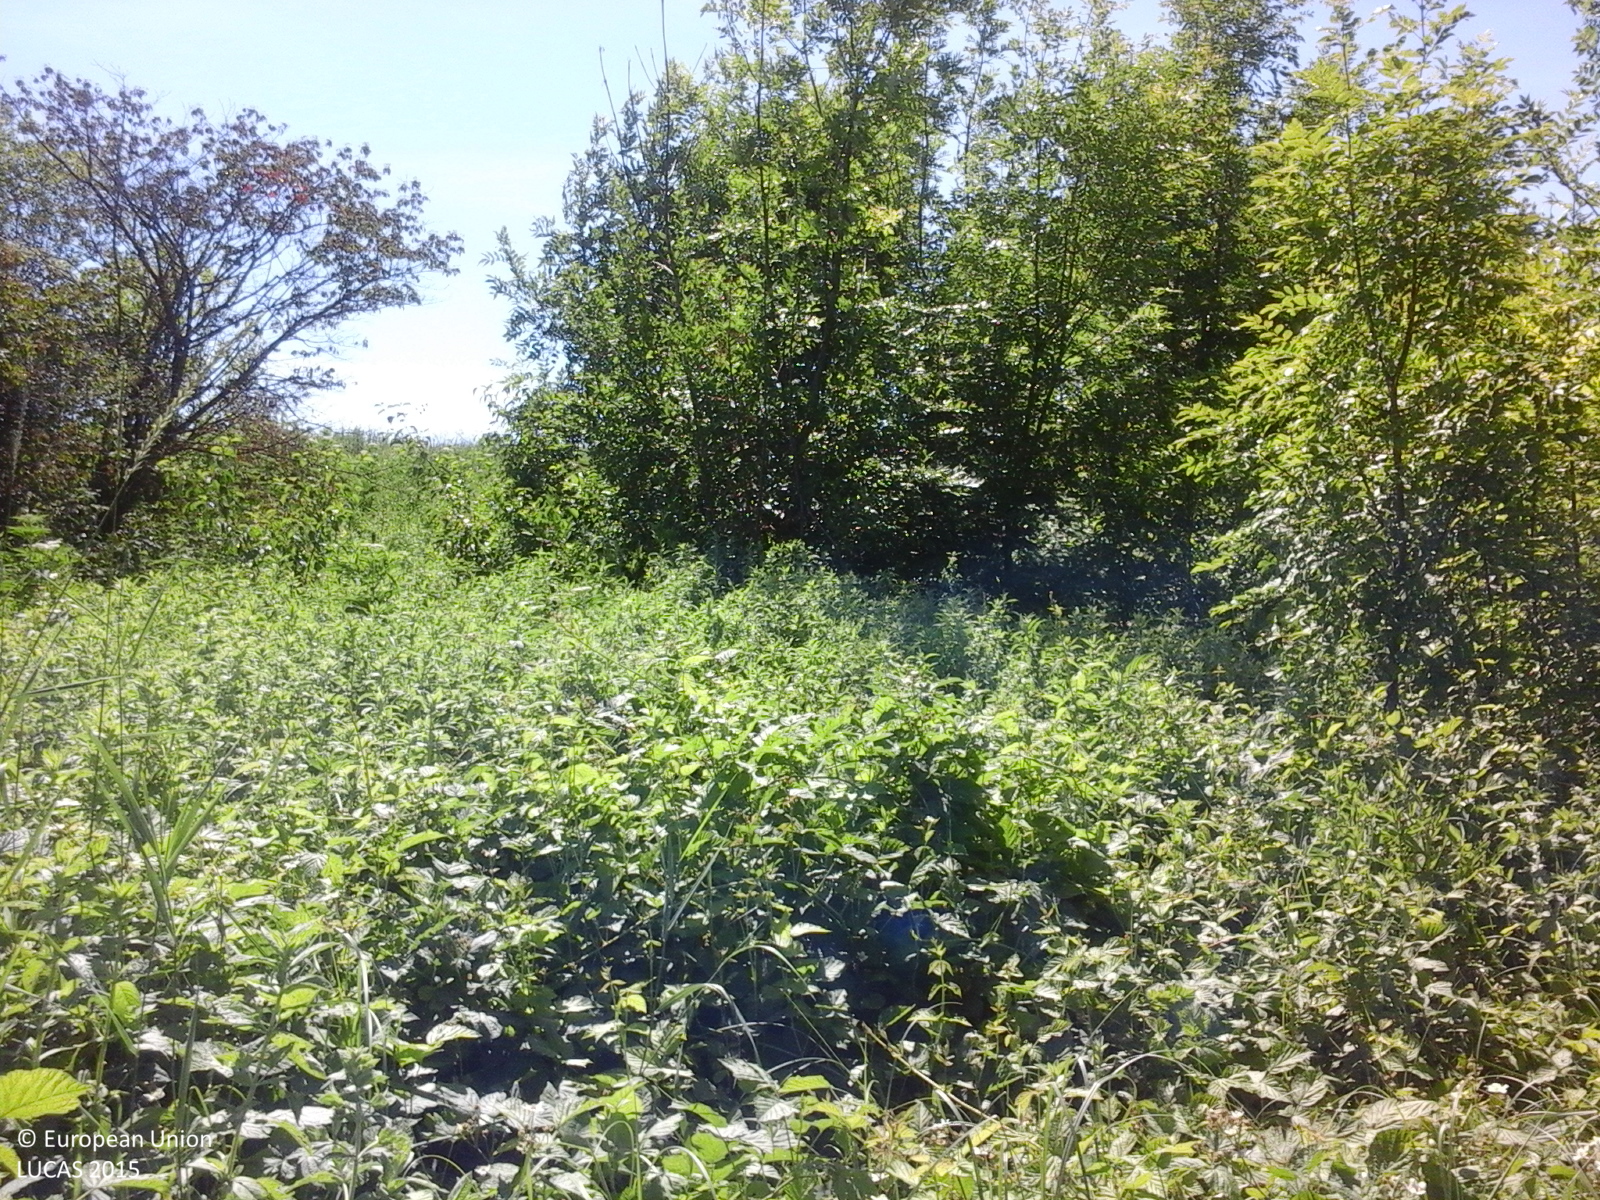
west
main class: Woodland
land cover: Broadleaved woodland
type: thermophilous deciduous forest
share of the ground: > 75 %
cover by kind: broadleaved forest trees 100 %
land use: Forestry
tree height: > 5 m
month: June
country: RO
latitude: 47.0879
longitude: 27.0280
